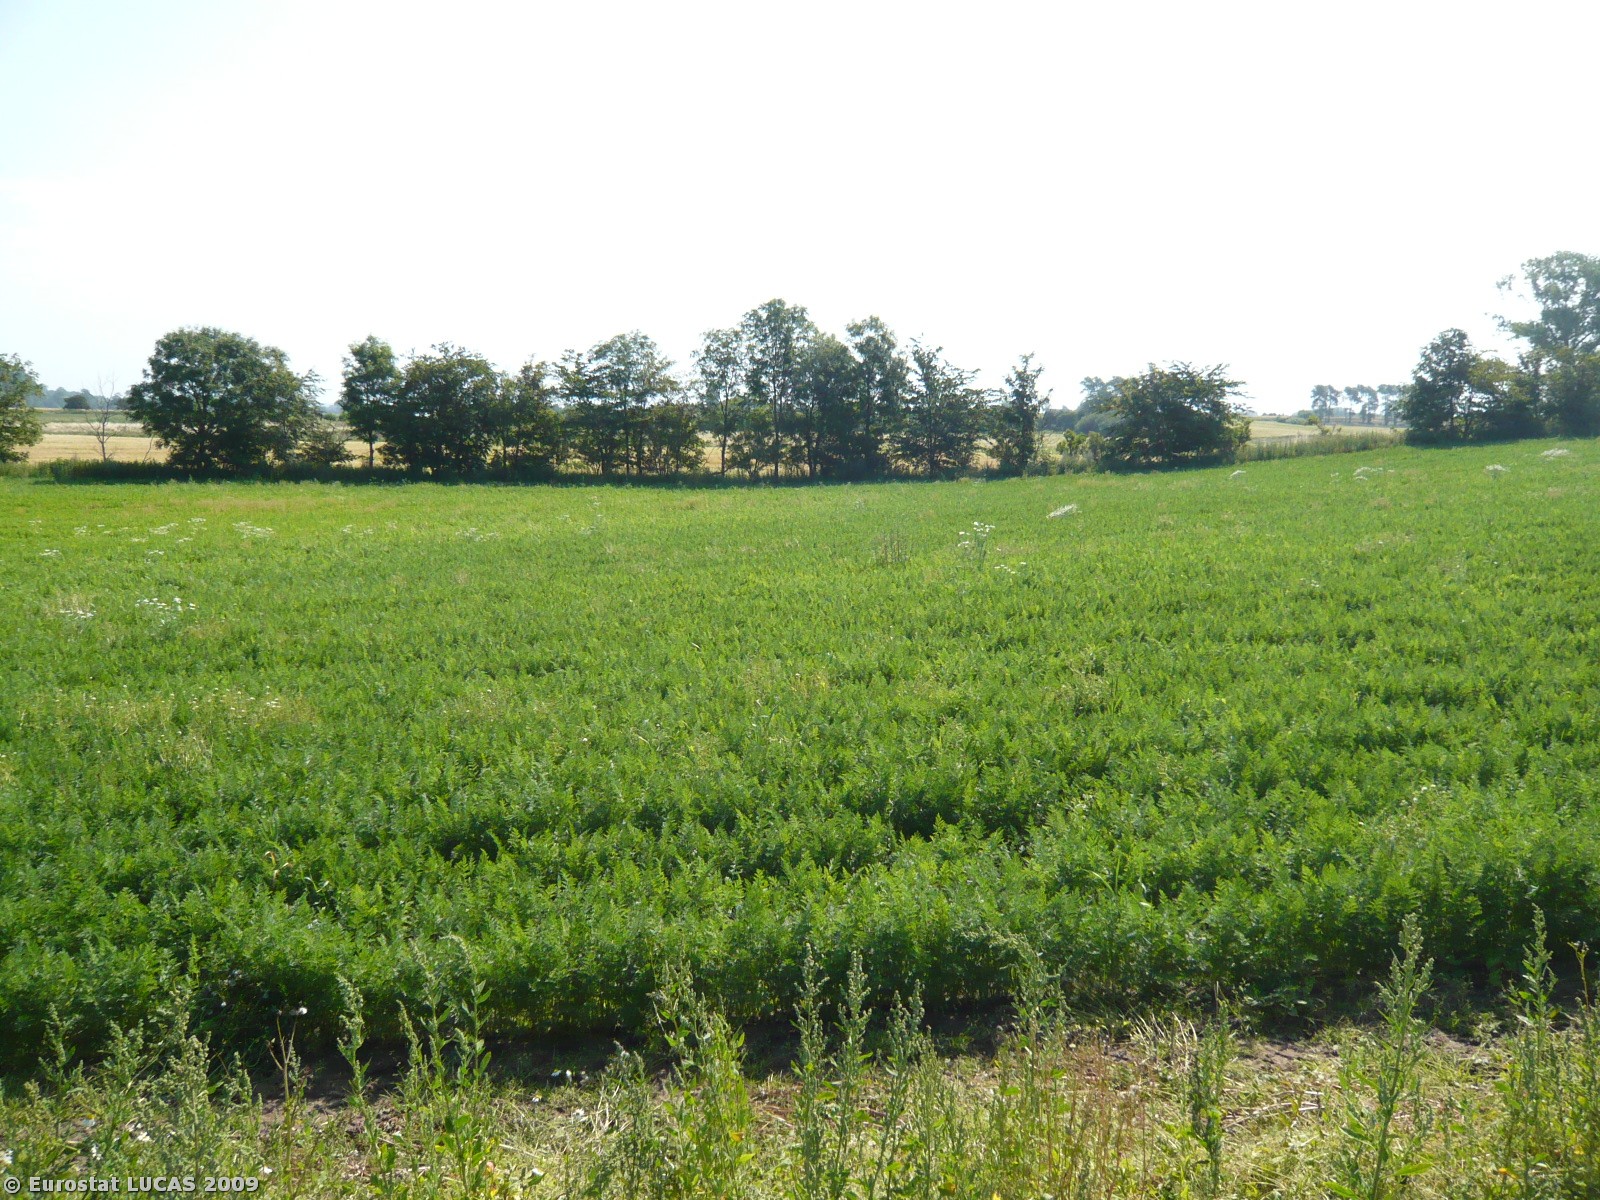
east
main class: Cropland
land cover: Barley
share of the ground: > 75 %
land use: Agriculture (excluding fallow land and kitchen gardens)
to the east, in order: Barley; Grass margins; Other fresh vegetables; Broadleaved woodland; Barley; Grass margins; Barley
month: July
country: DK
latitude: 55.7668
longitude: 11.3853
